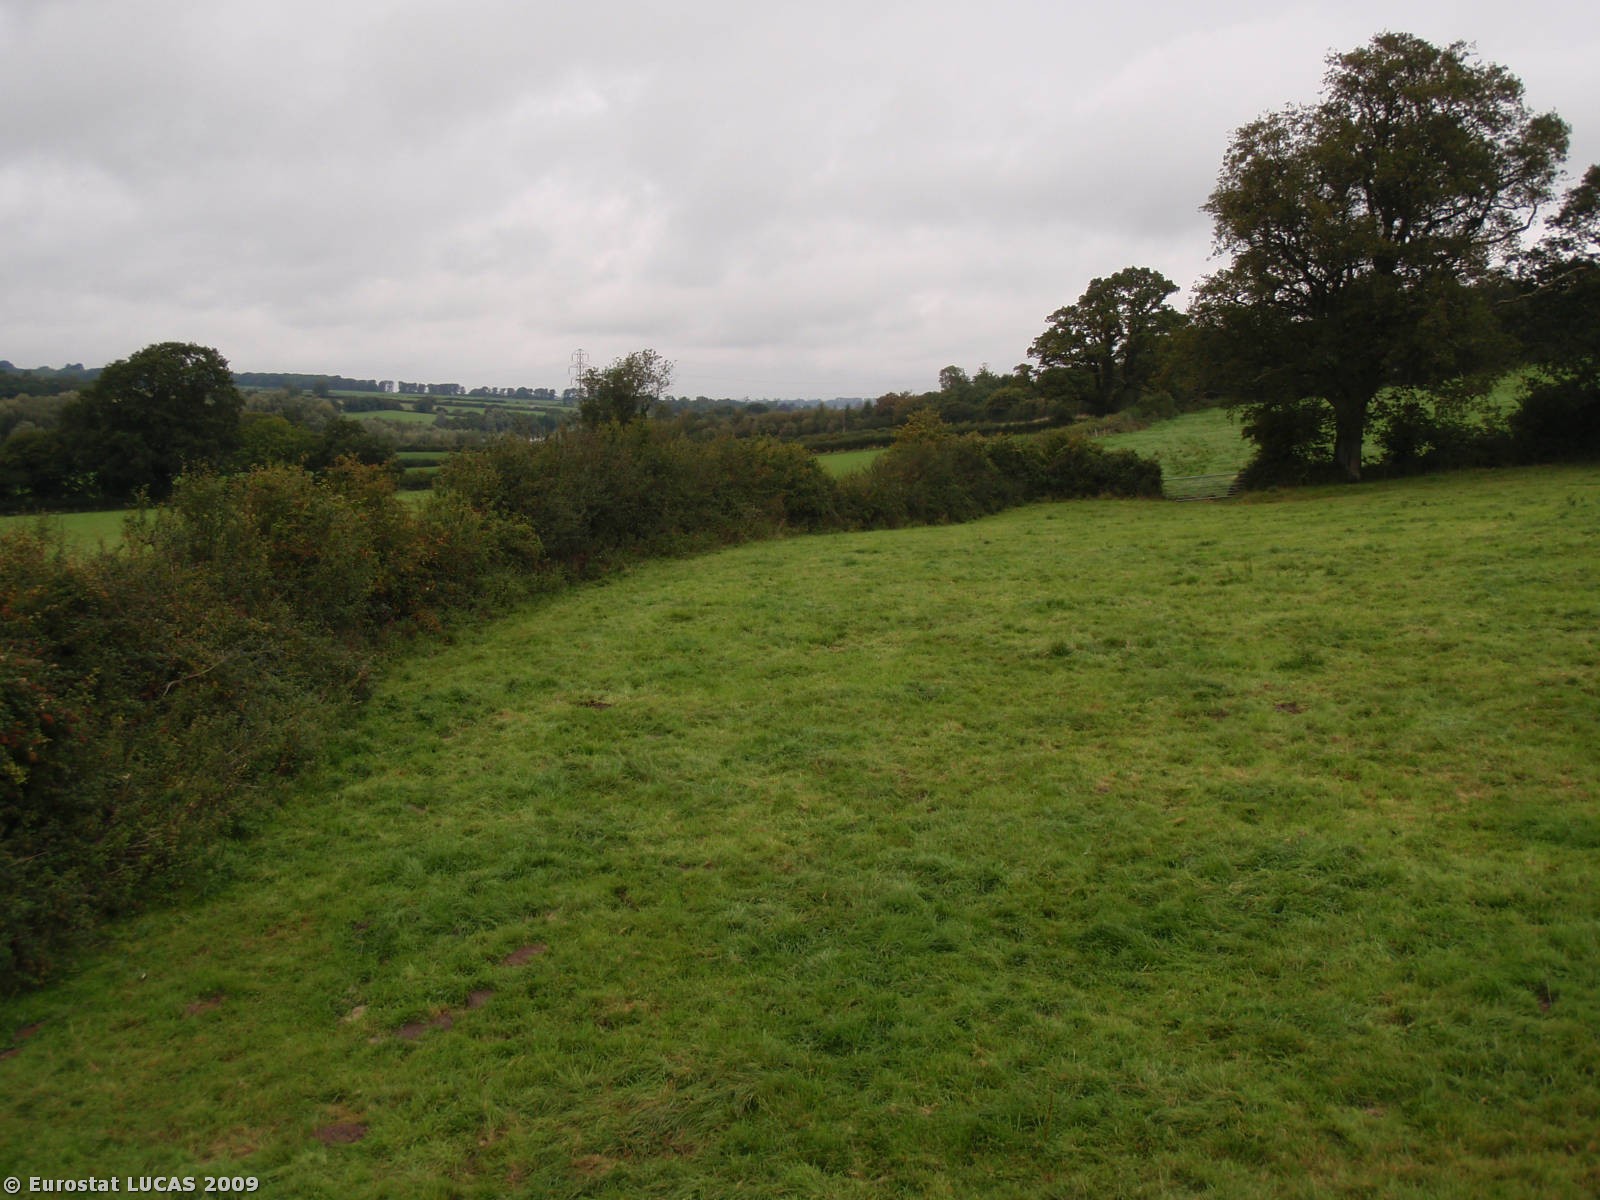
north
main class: Cropland
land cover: Maize
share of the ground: > 75 %
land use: Agriculture (excluding fallow land and kitchen gardens)
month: September
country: GB
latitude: 50.8784
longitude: -2.6467
